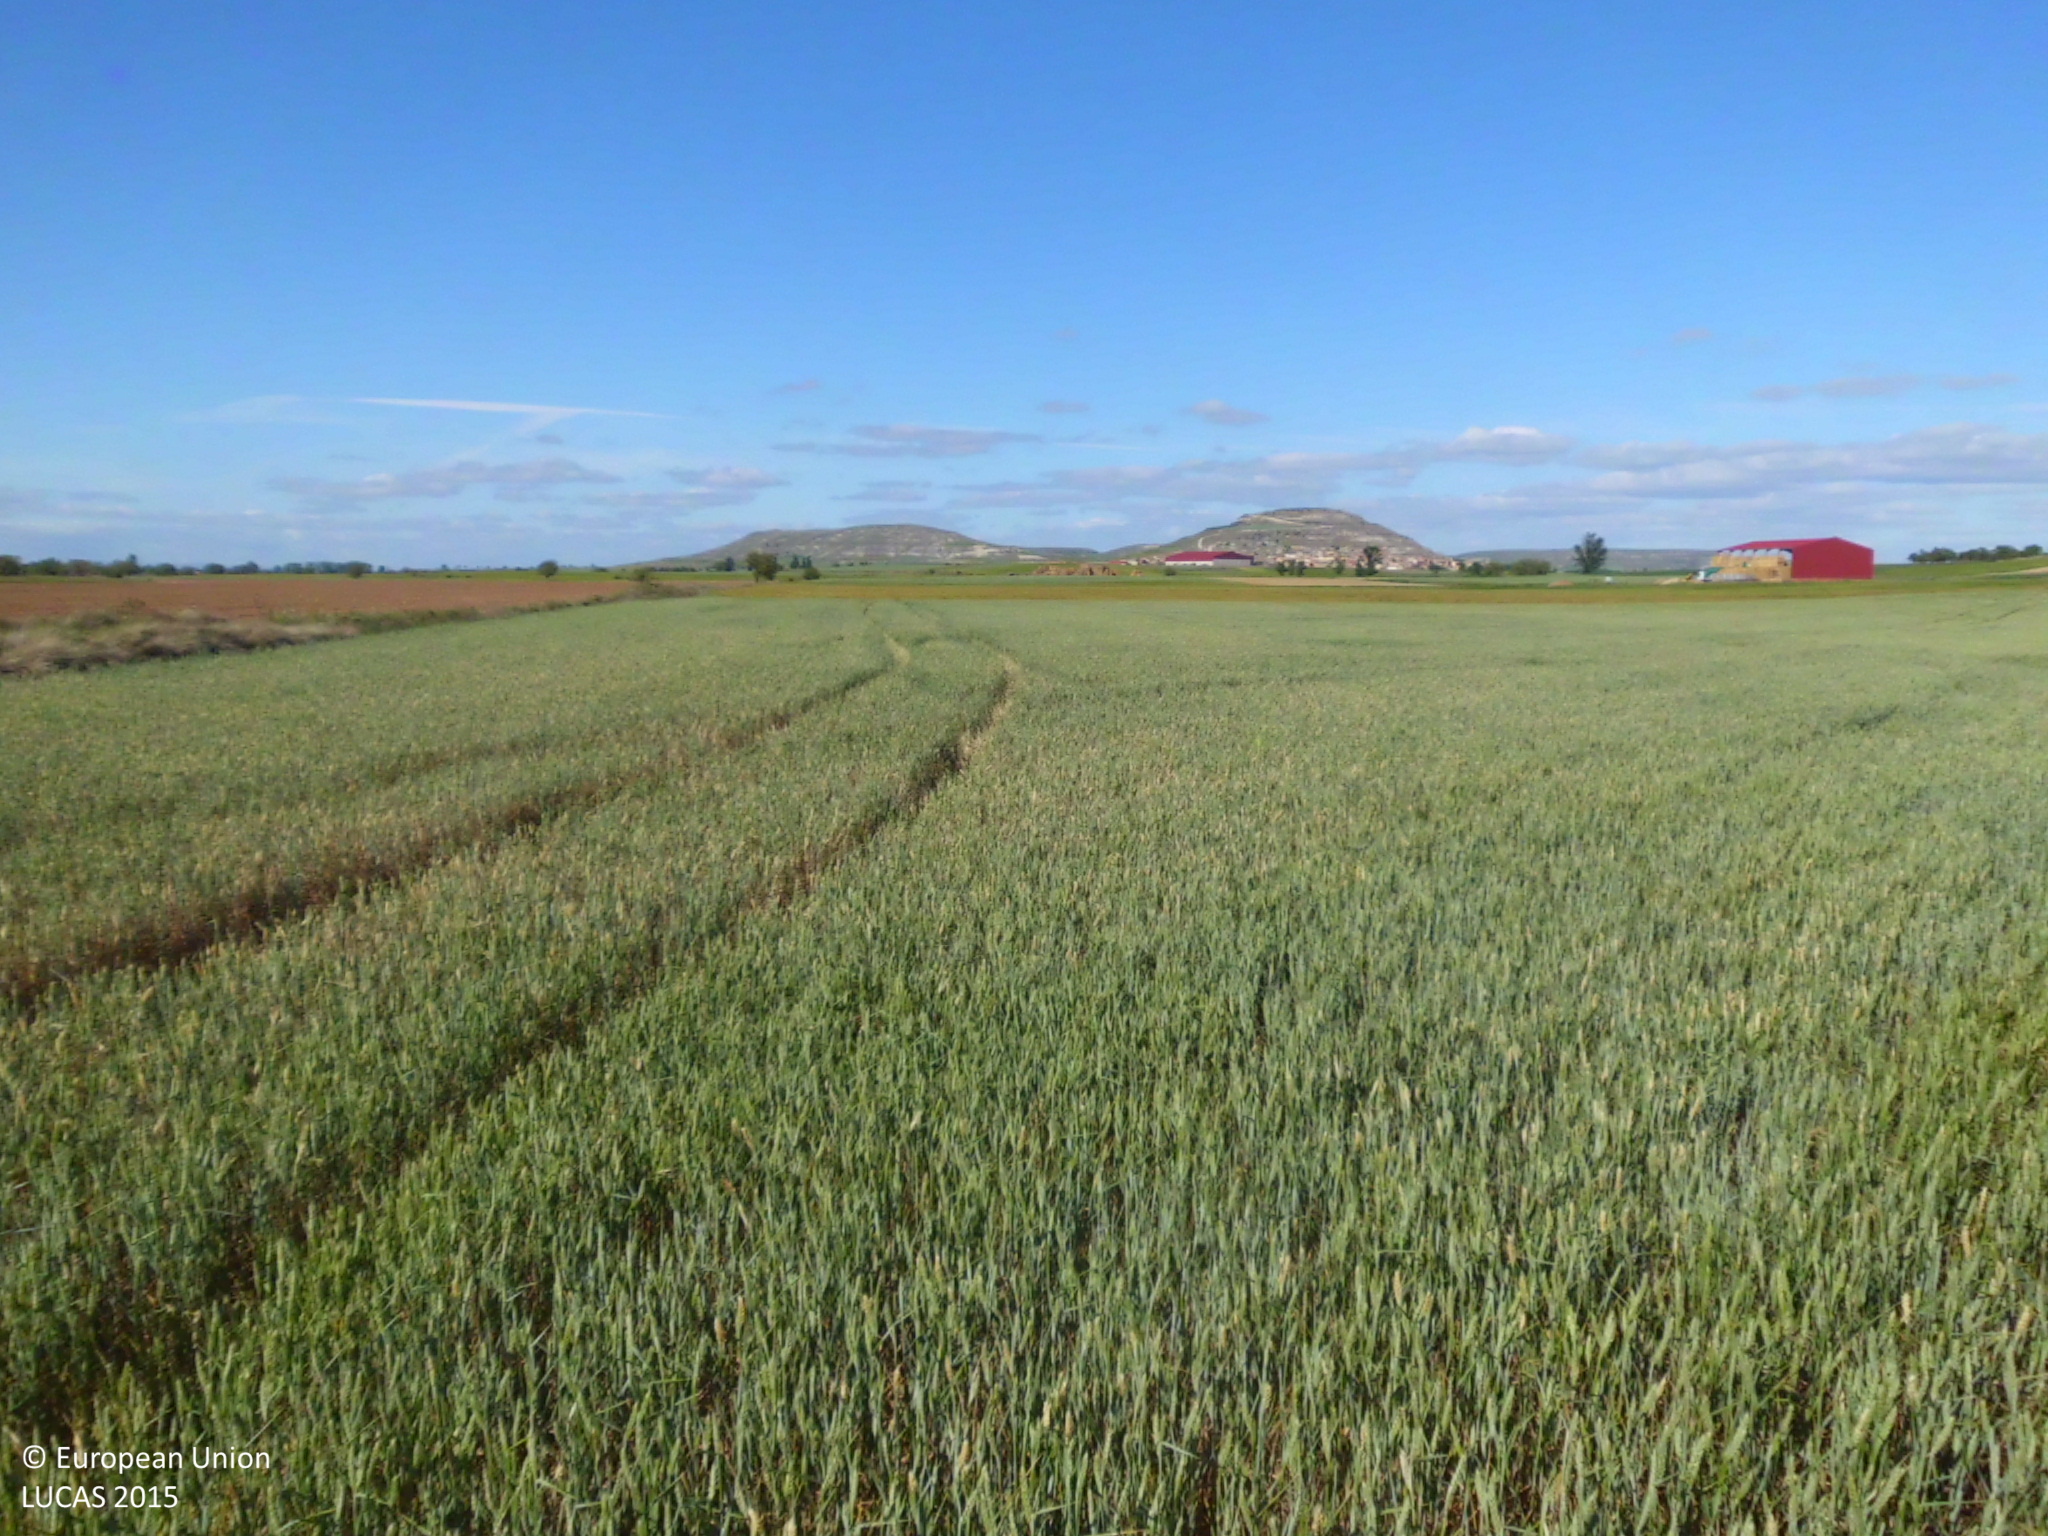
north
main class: Cropland
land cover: Common wheat
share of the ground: > 75 %
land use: Agriculture (excluding fallow land and kitchen gardens)
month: May
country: ES
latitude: 42.2747
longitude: -4.1687
